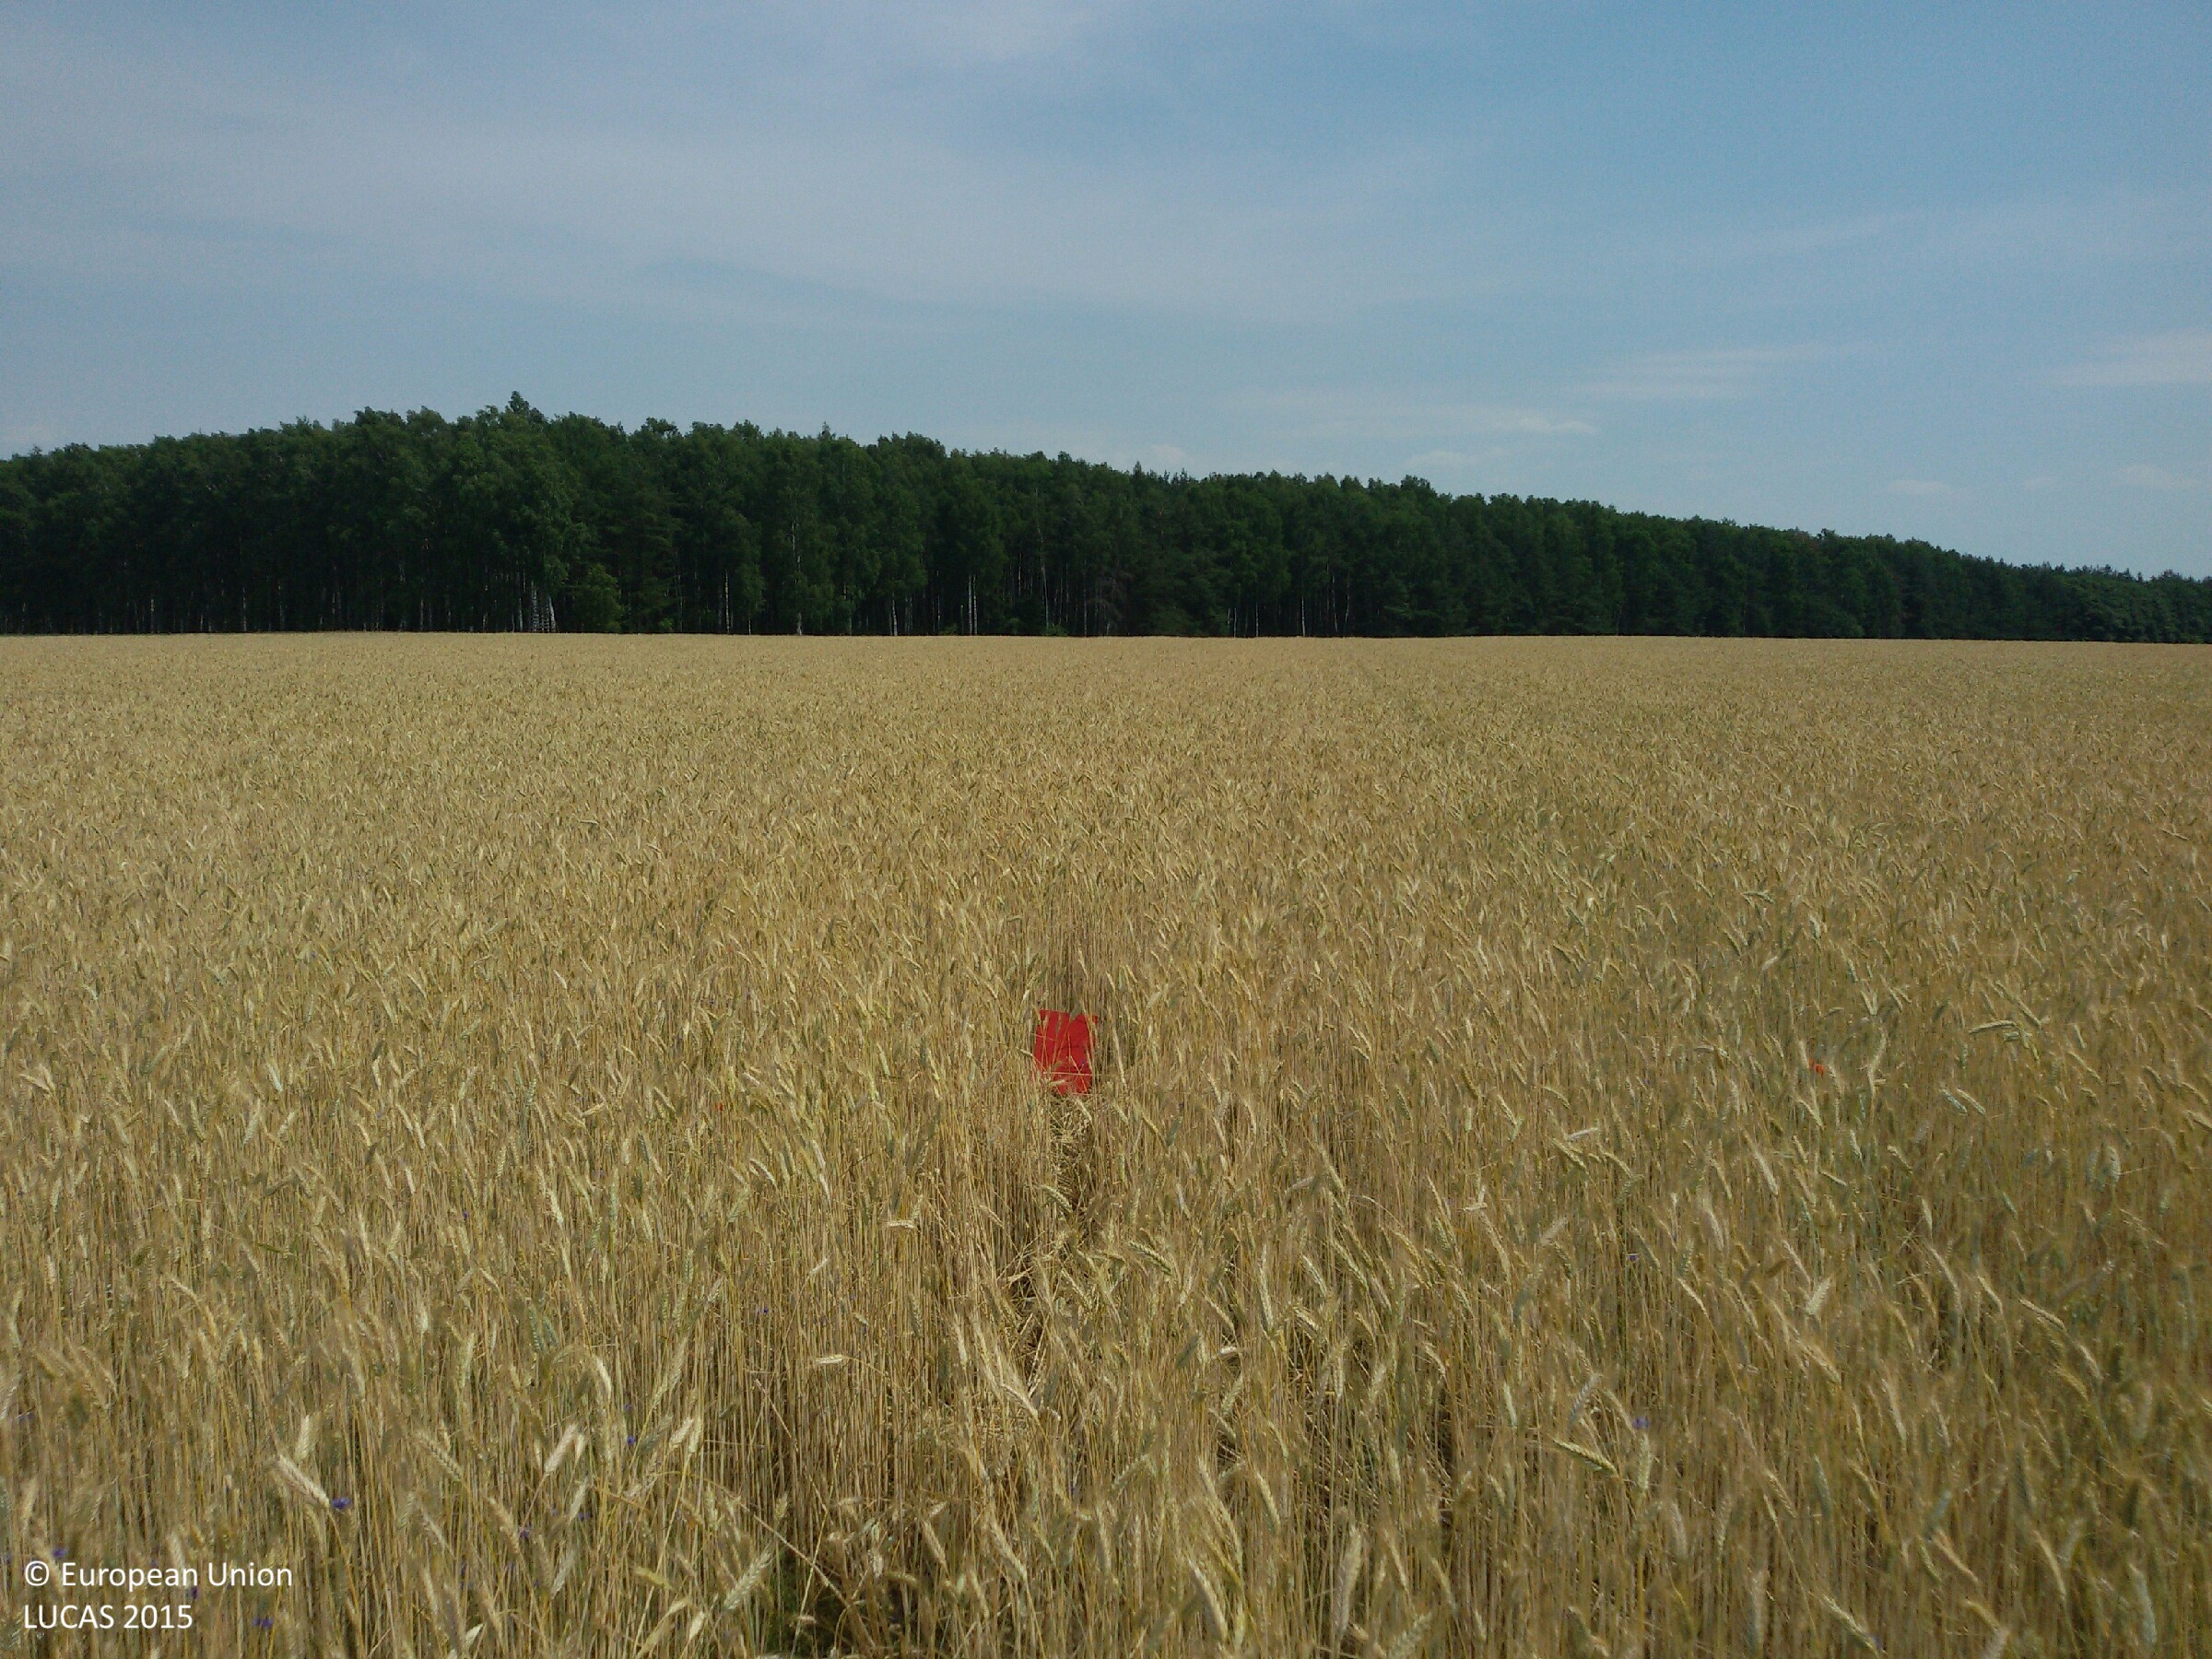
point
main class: Cropland
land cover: Common wheat
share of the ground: > 75 %
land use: Agriculture (excluding fallow land and kitchen gardens)
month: July
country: PL
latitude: 53.2869
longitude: 20.0982
